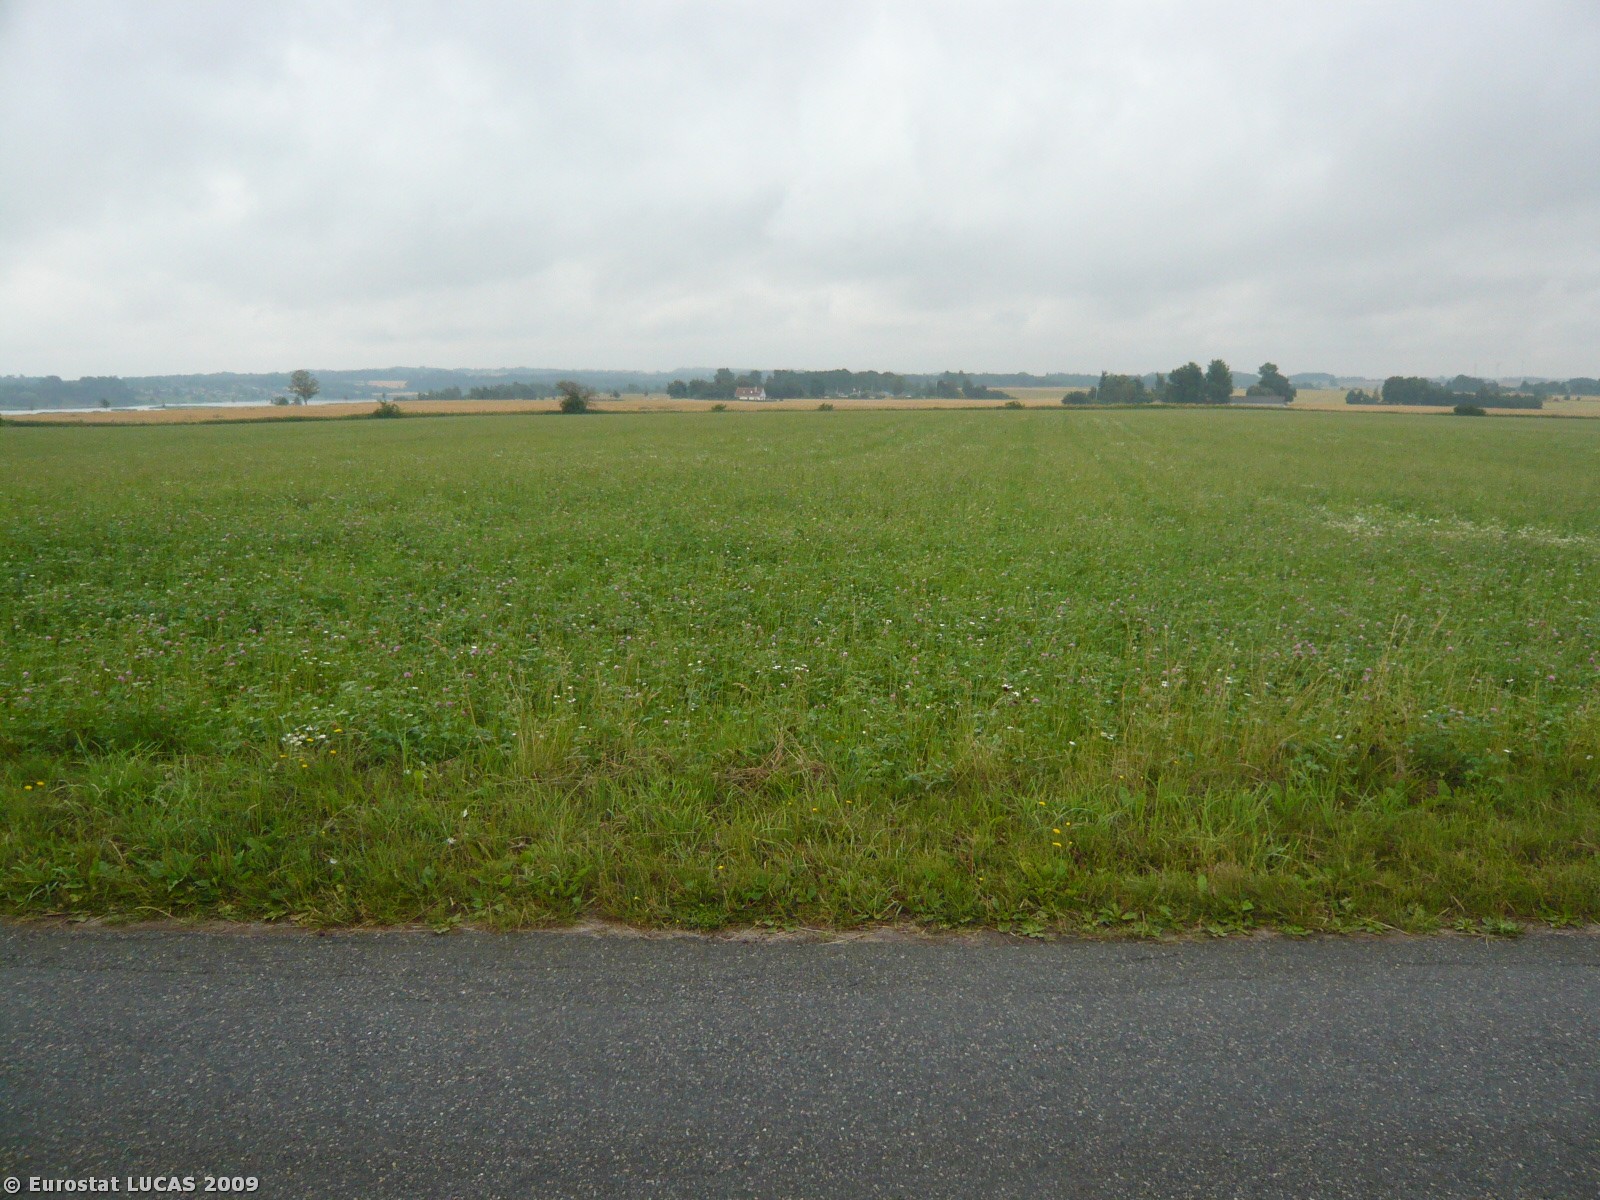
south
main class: Cropland
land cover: Durum wheat
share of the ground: > 75 %
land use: Agriculture (excluding fallow land and kitchen gardens)
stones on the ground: < 10 %
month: July
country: DK
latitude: 55.6699
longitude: 11.9221
